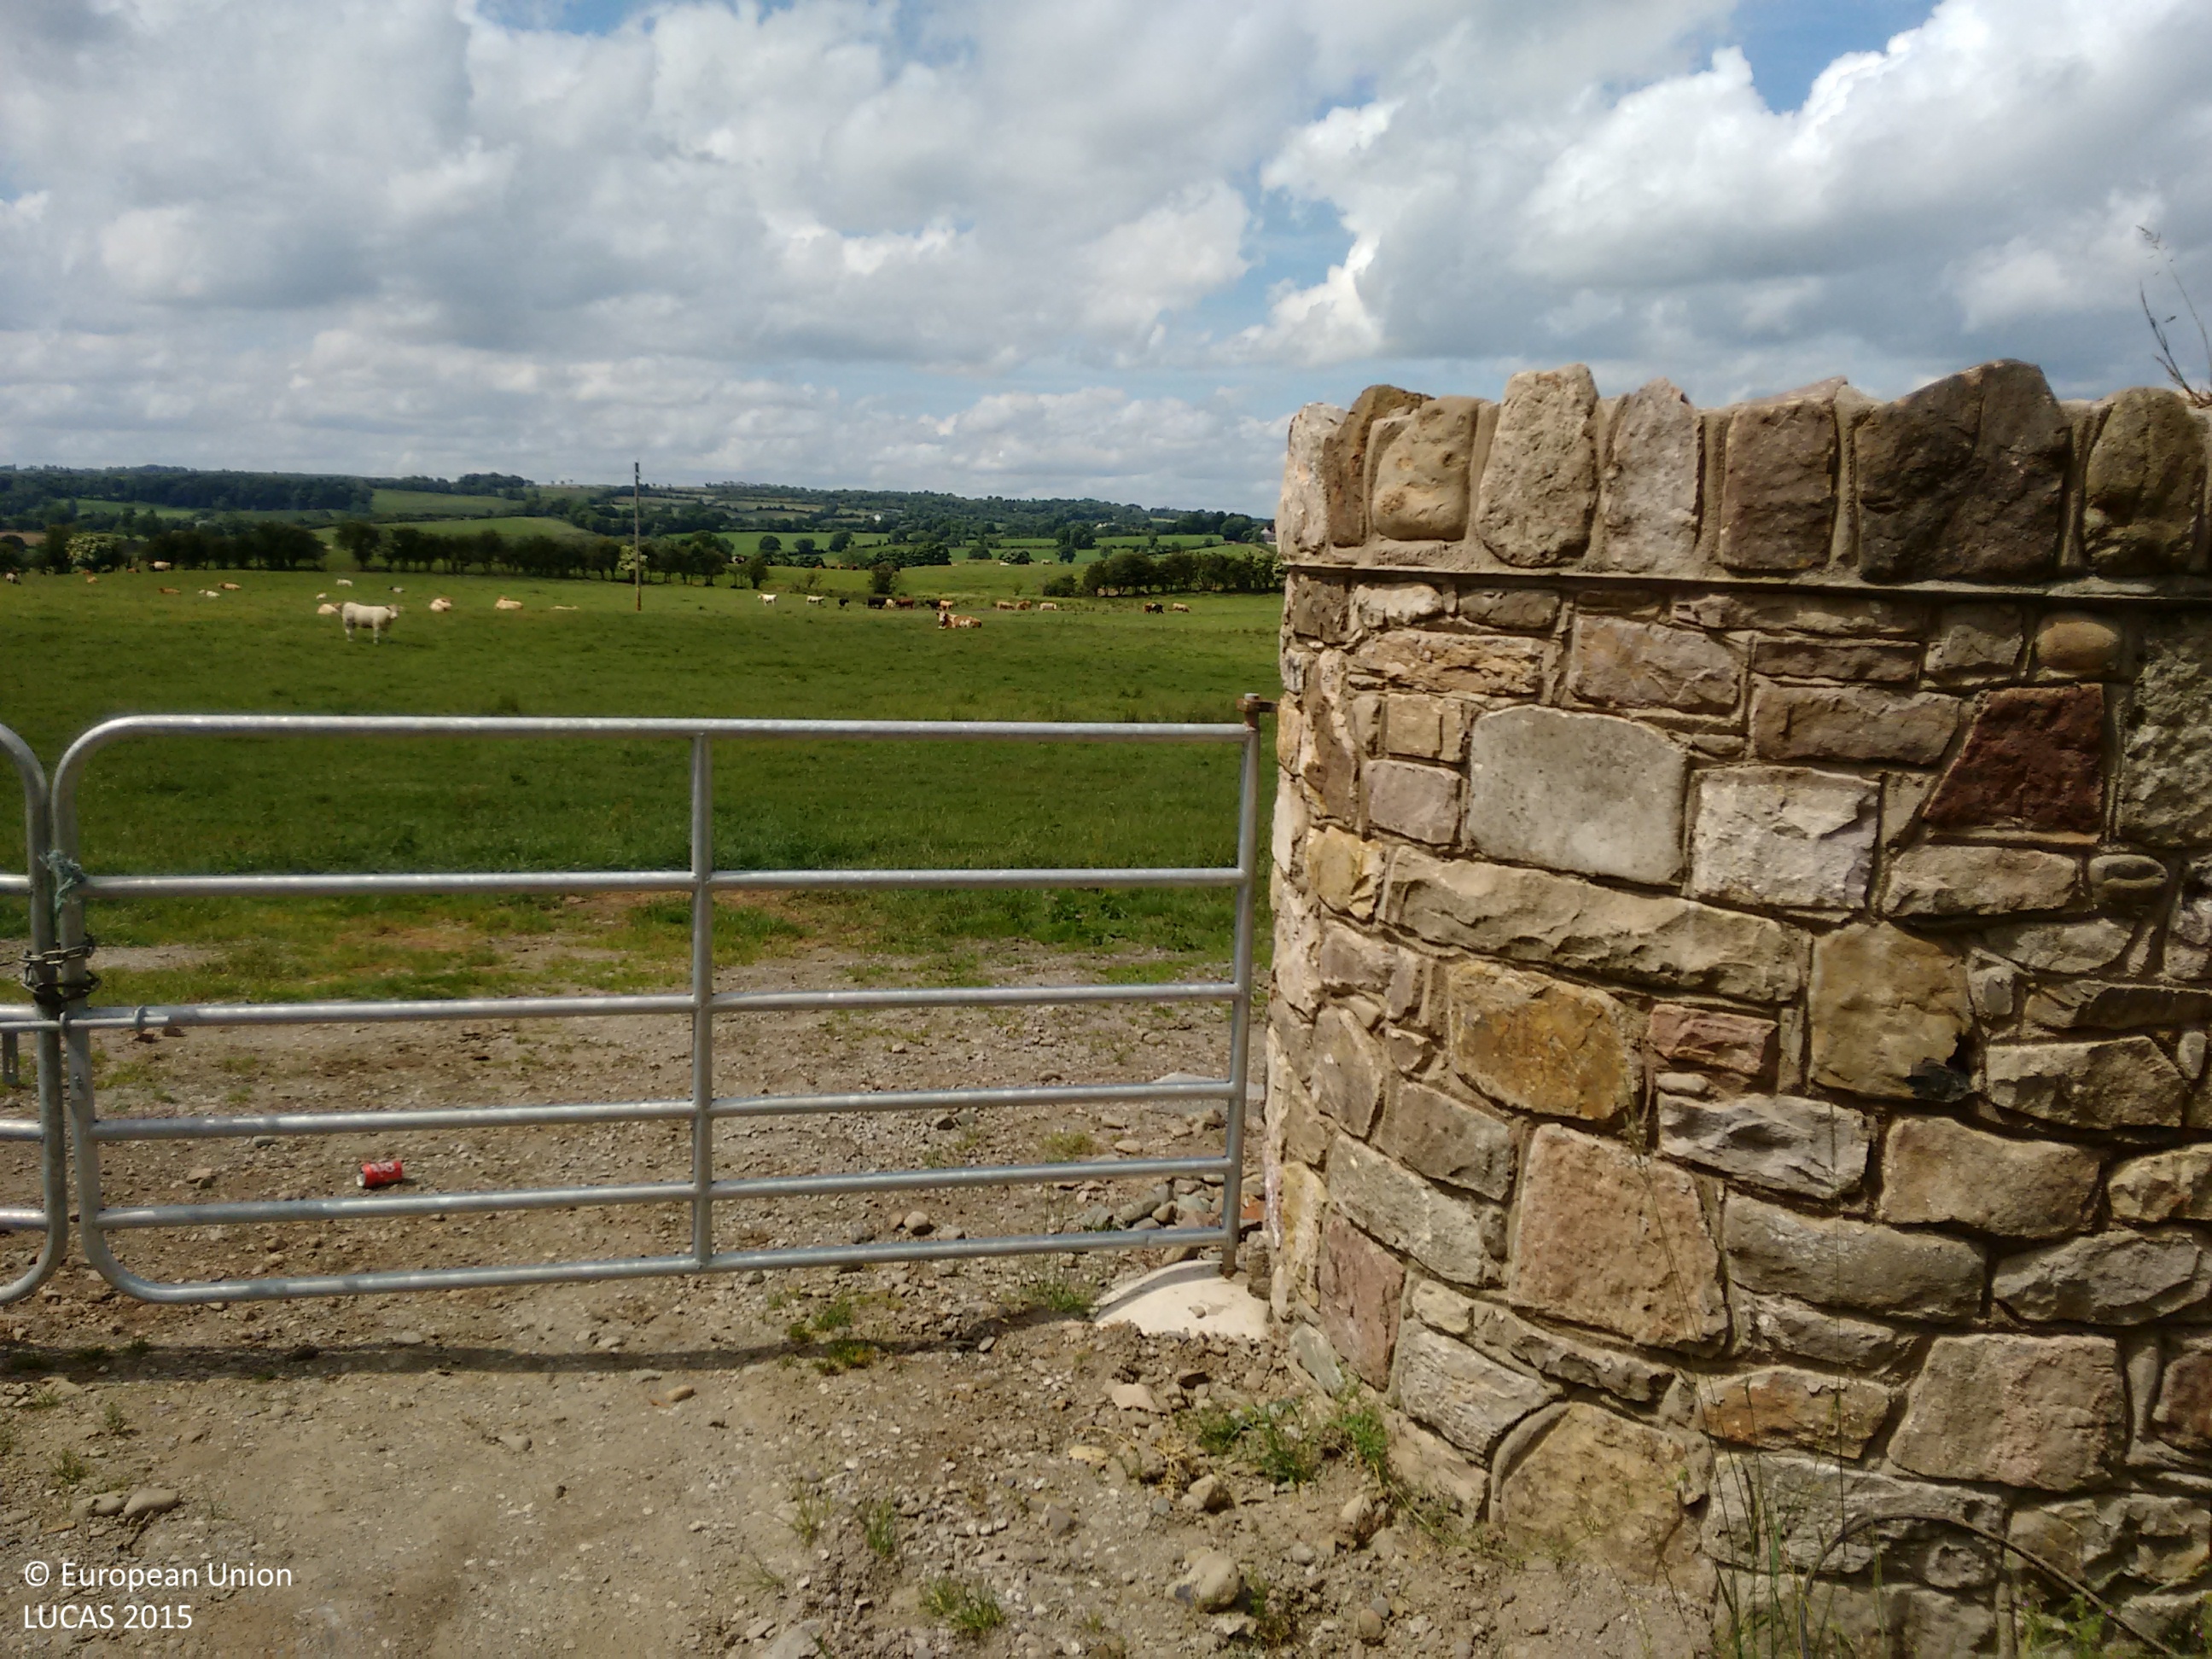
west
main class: Grassland
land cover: Grassland without tree/shrub cover
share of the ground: > 75 %
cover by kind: herbaceous plants 100 %
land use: Agriculture (excluding fallow land and kitchen gardens)
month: July
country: IE
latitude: 53.8555
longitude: -6.7817
